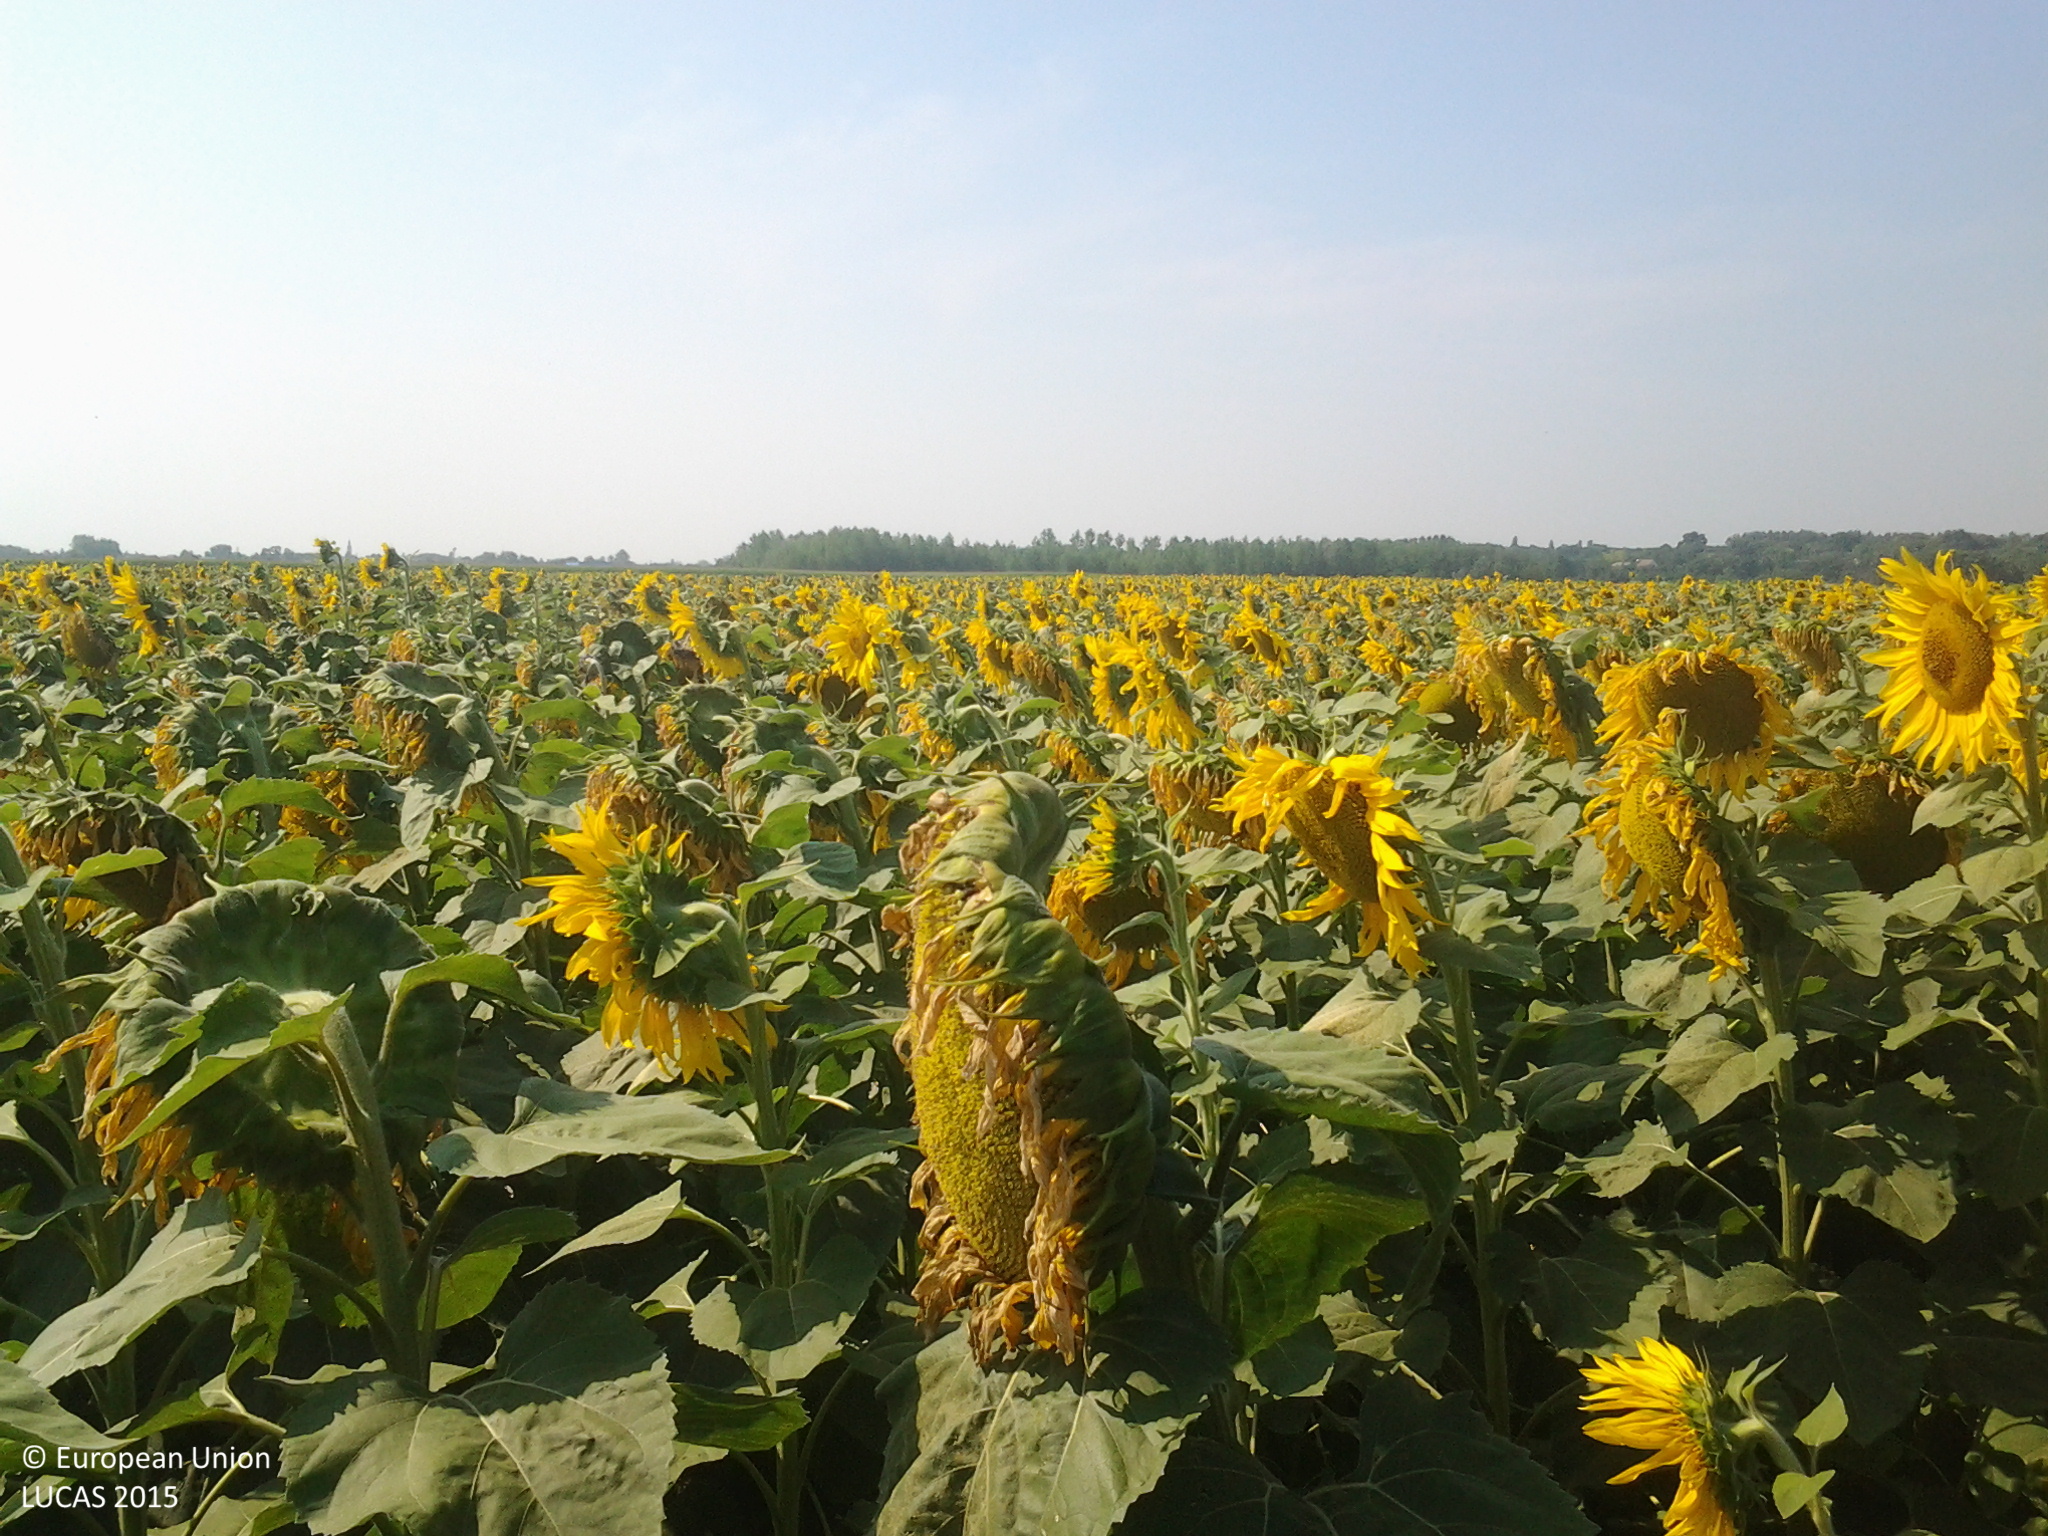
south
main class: Cropland
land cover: Sunflower
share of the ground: > 75 %
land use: Agriculture (excluding fallow land and kitchen gardens)
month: July
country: HU
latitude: 46.8231
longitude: 18.9938
